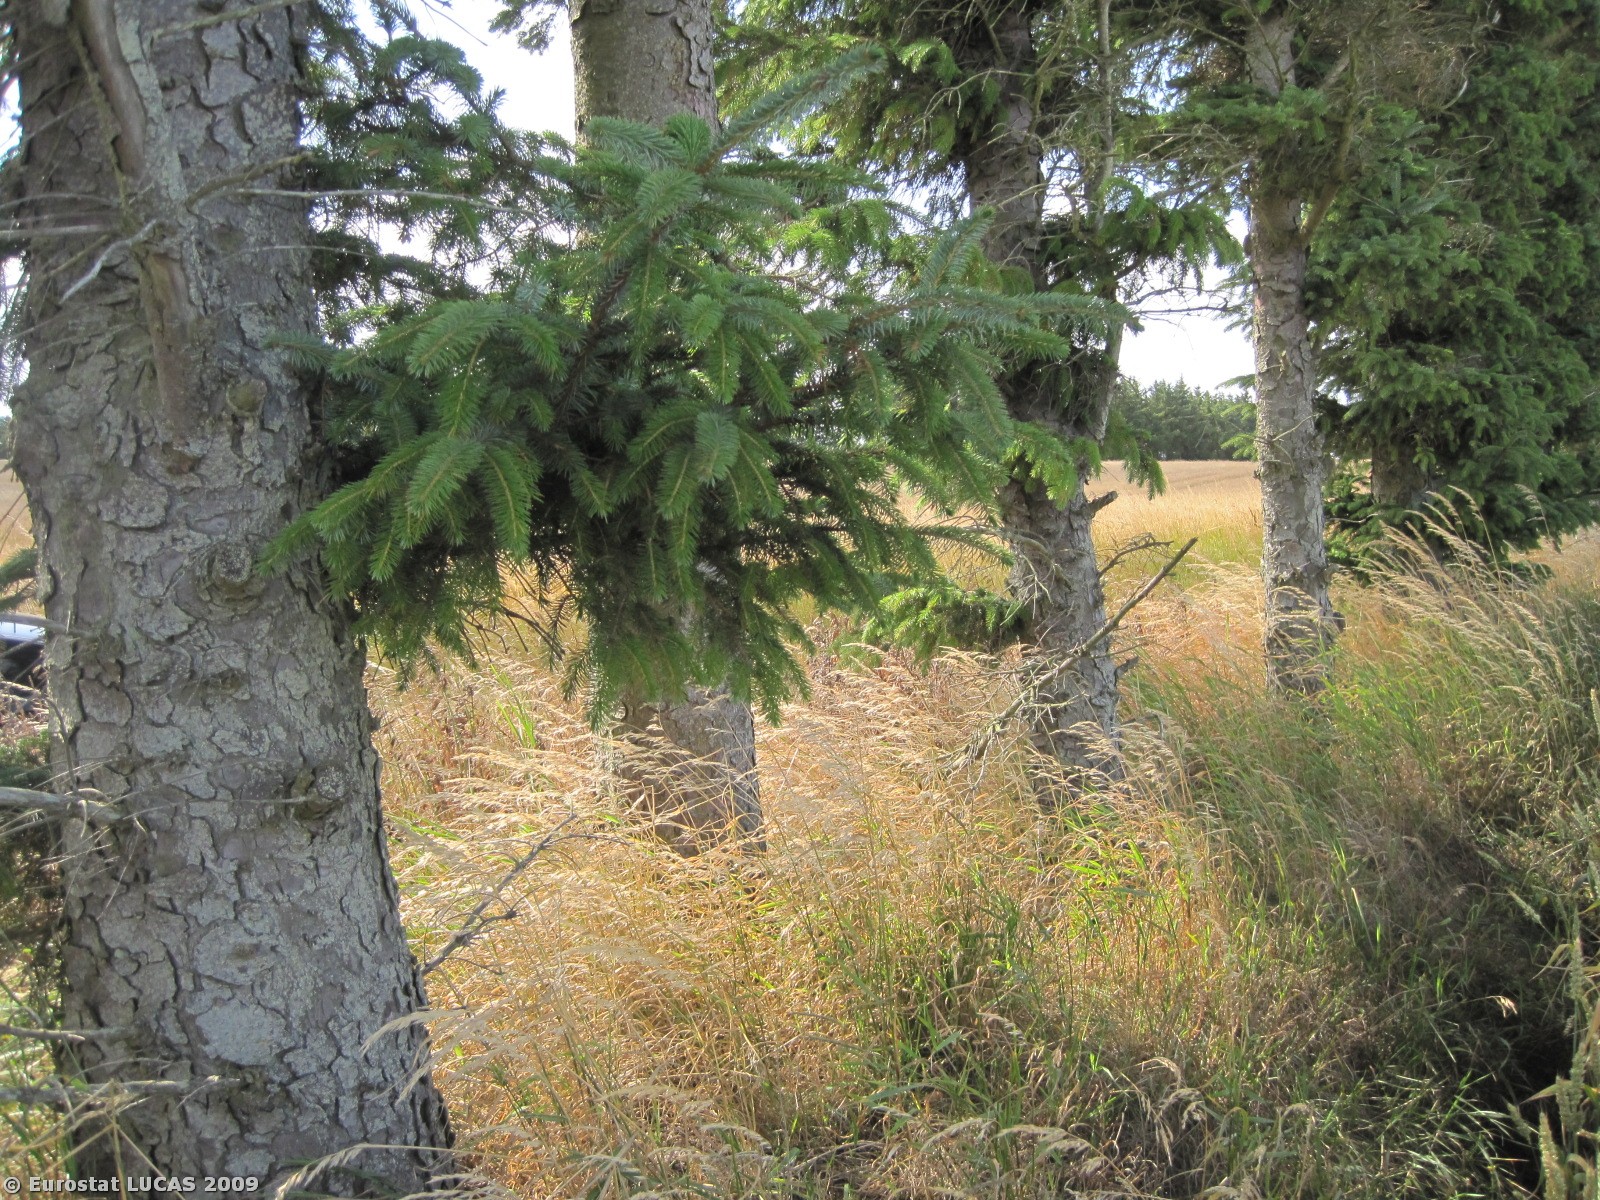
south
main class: Cropland
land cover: Common wheat
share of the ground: > 75 %
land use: Agriculture (excluding fallow land and kitchen gardens)
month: July
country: DK
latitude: 56.7002
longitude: 8.4832
